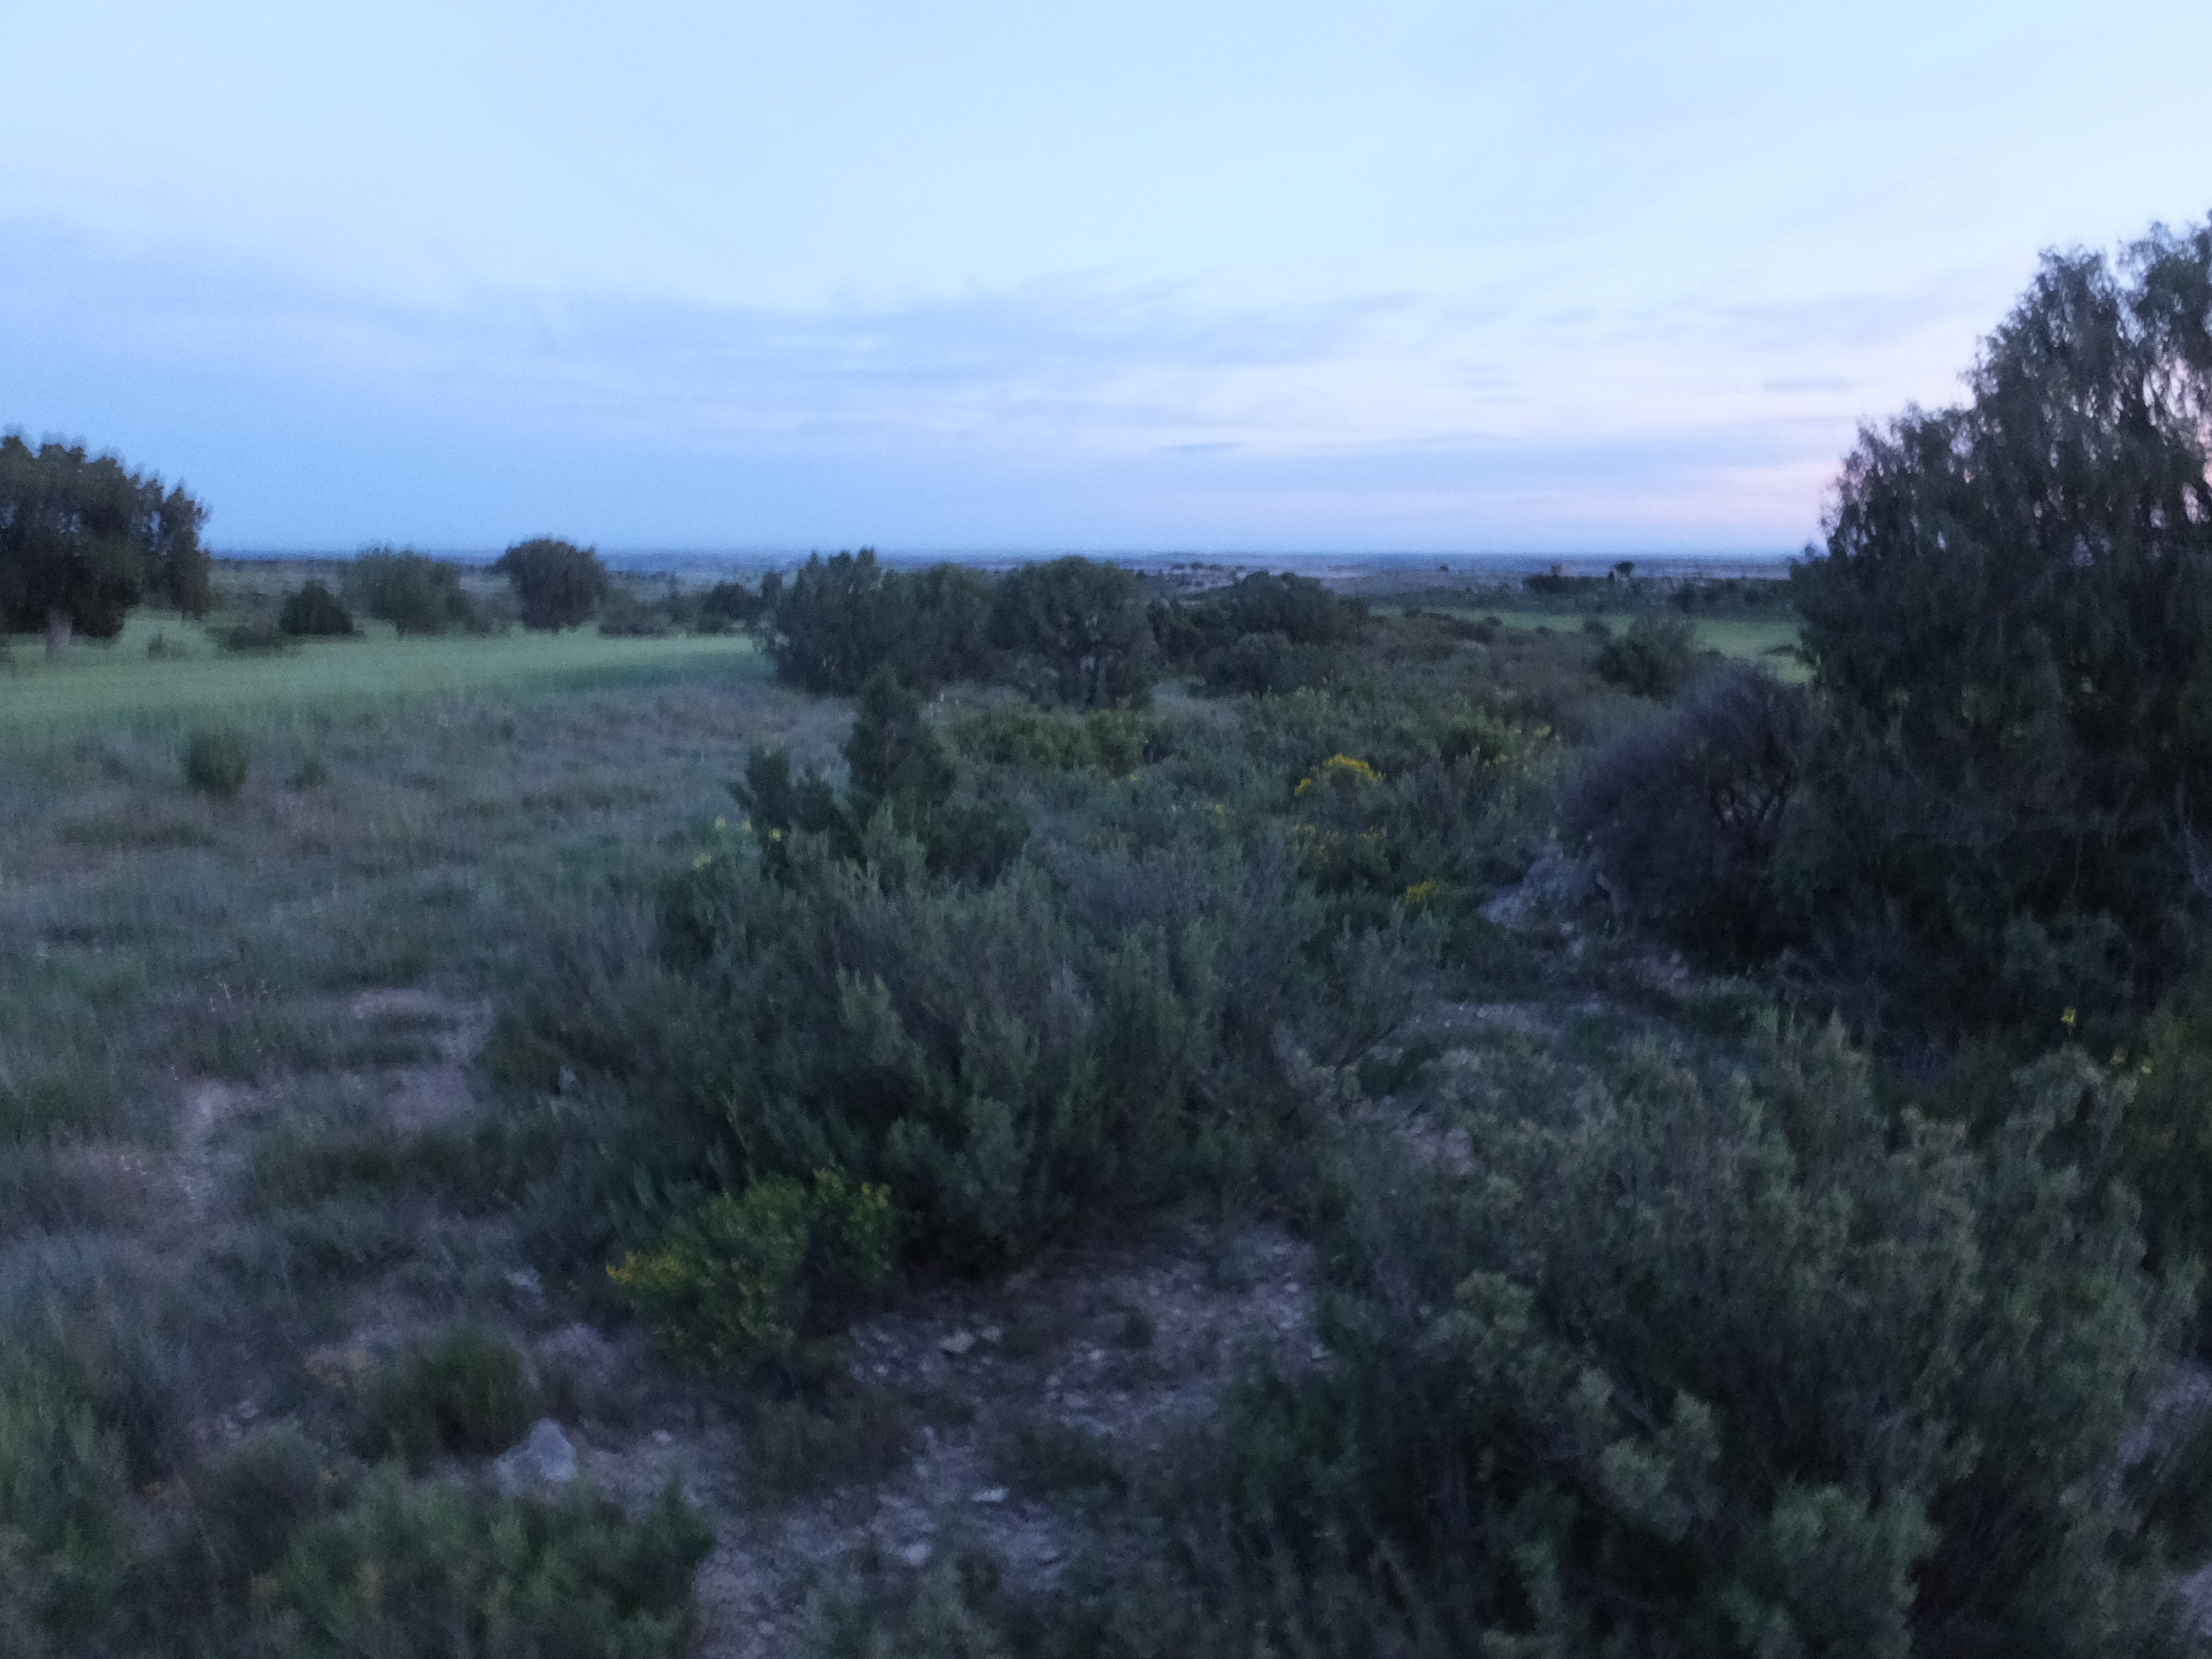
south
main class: Shrubland
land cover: Shrubland with sparse tree cover
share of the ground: > 75 %
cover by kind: shrubs 75 %, herbaceous plants 20 %, coniferous forest trees 5 %
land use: Semi-natural and natural areas not in use
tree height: < 5 m
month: April
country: ES
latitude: 41.6373
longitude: -0.1125
